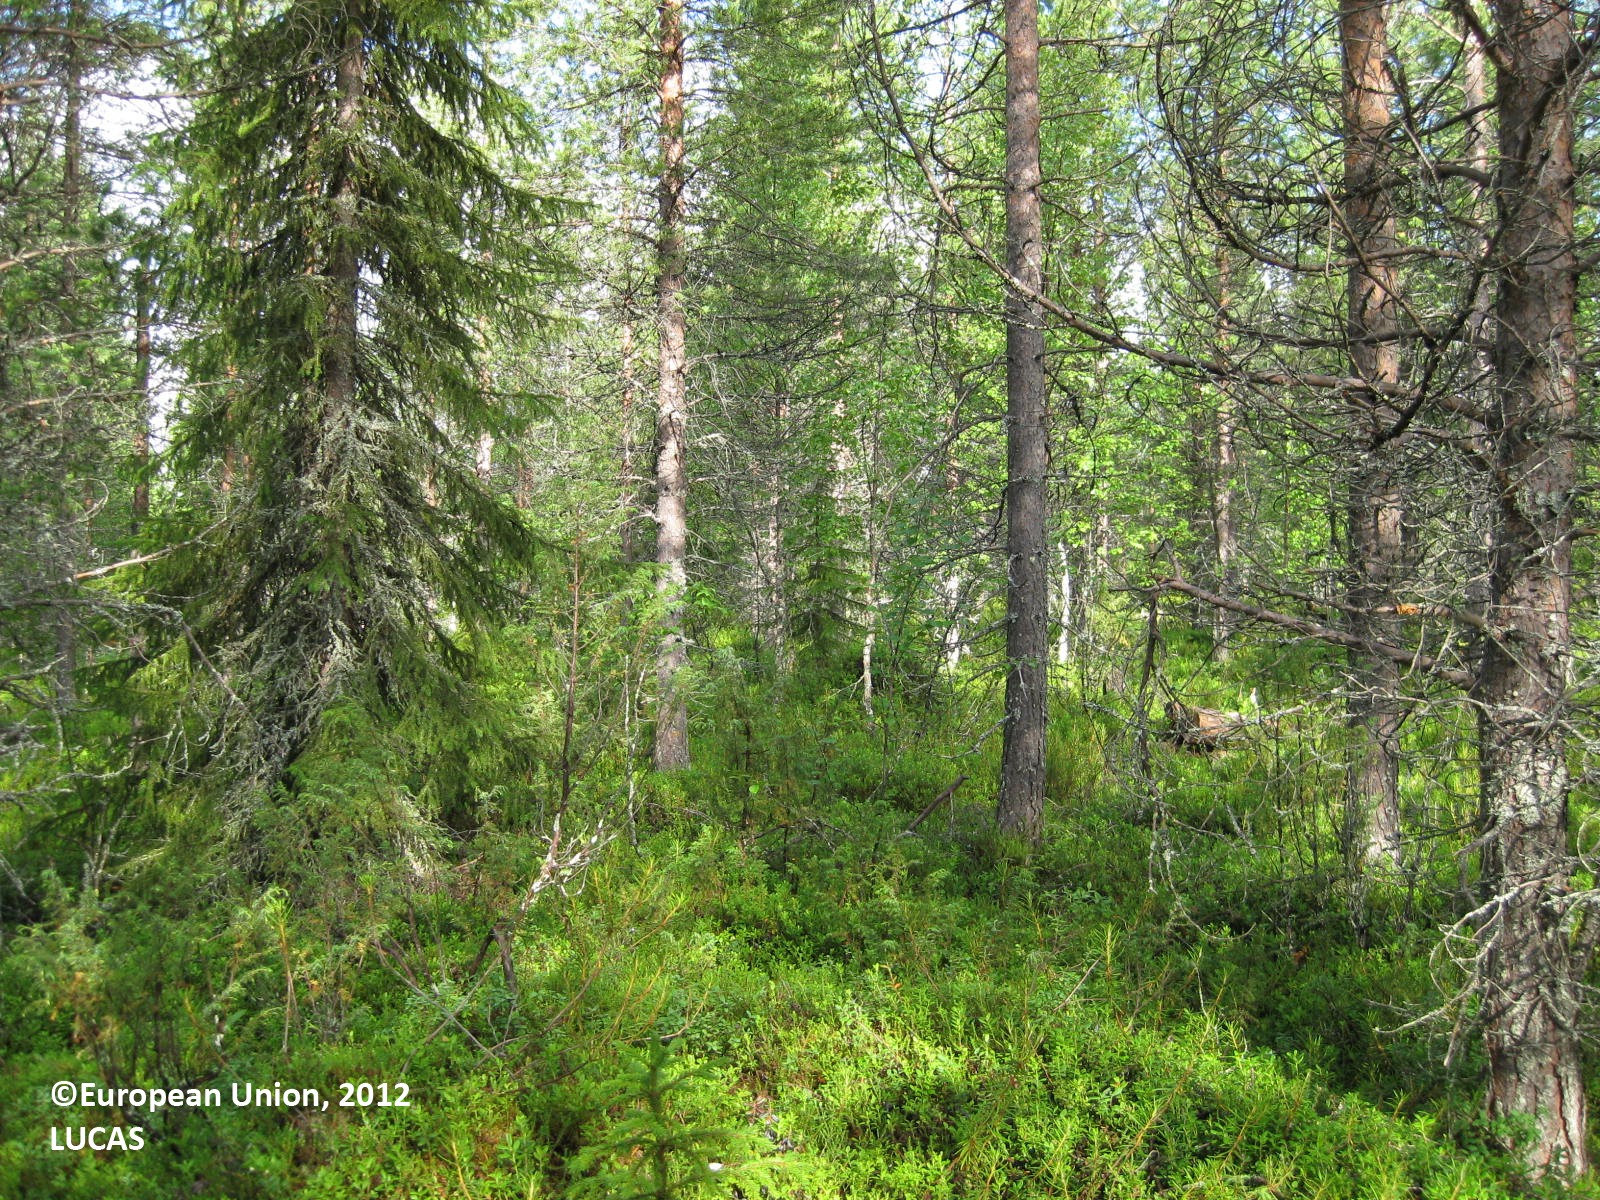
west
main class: Woodland
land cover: Pine dominated mixed woodland
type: boreal forest
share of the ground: > 75 %
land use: Forestry
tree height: > 5 m
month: July
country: FI
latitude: 65.6924
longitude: 29.4163
